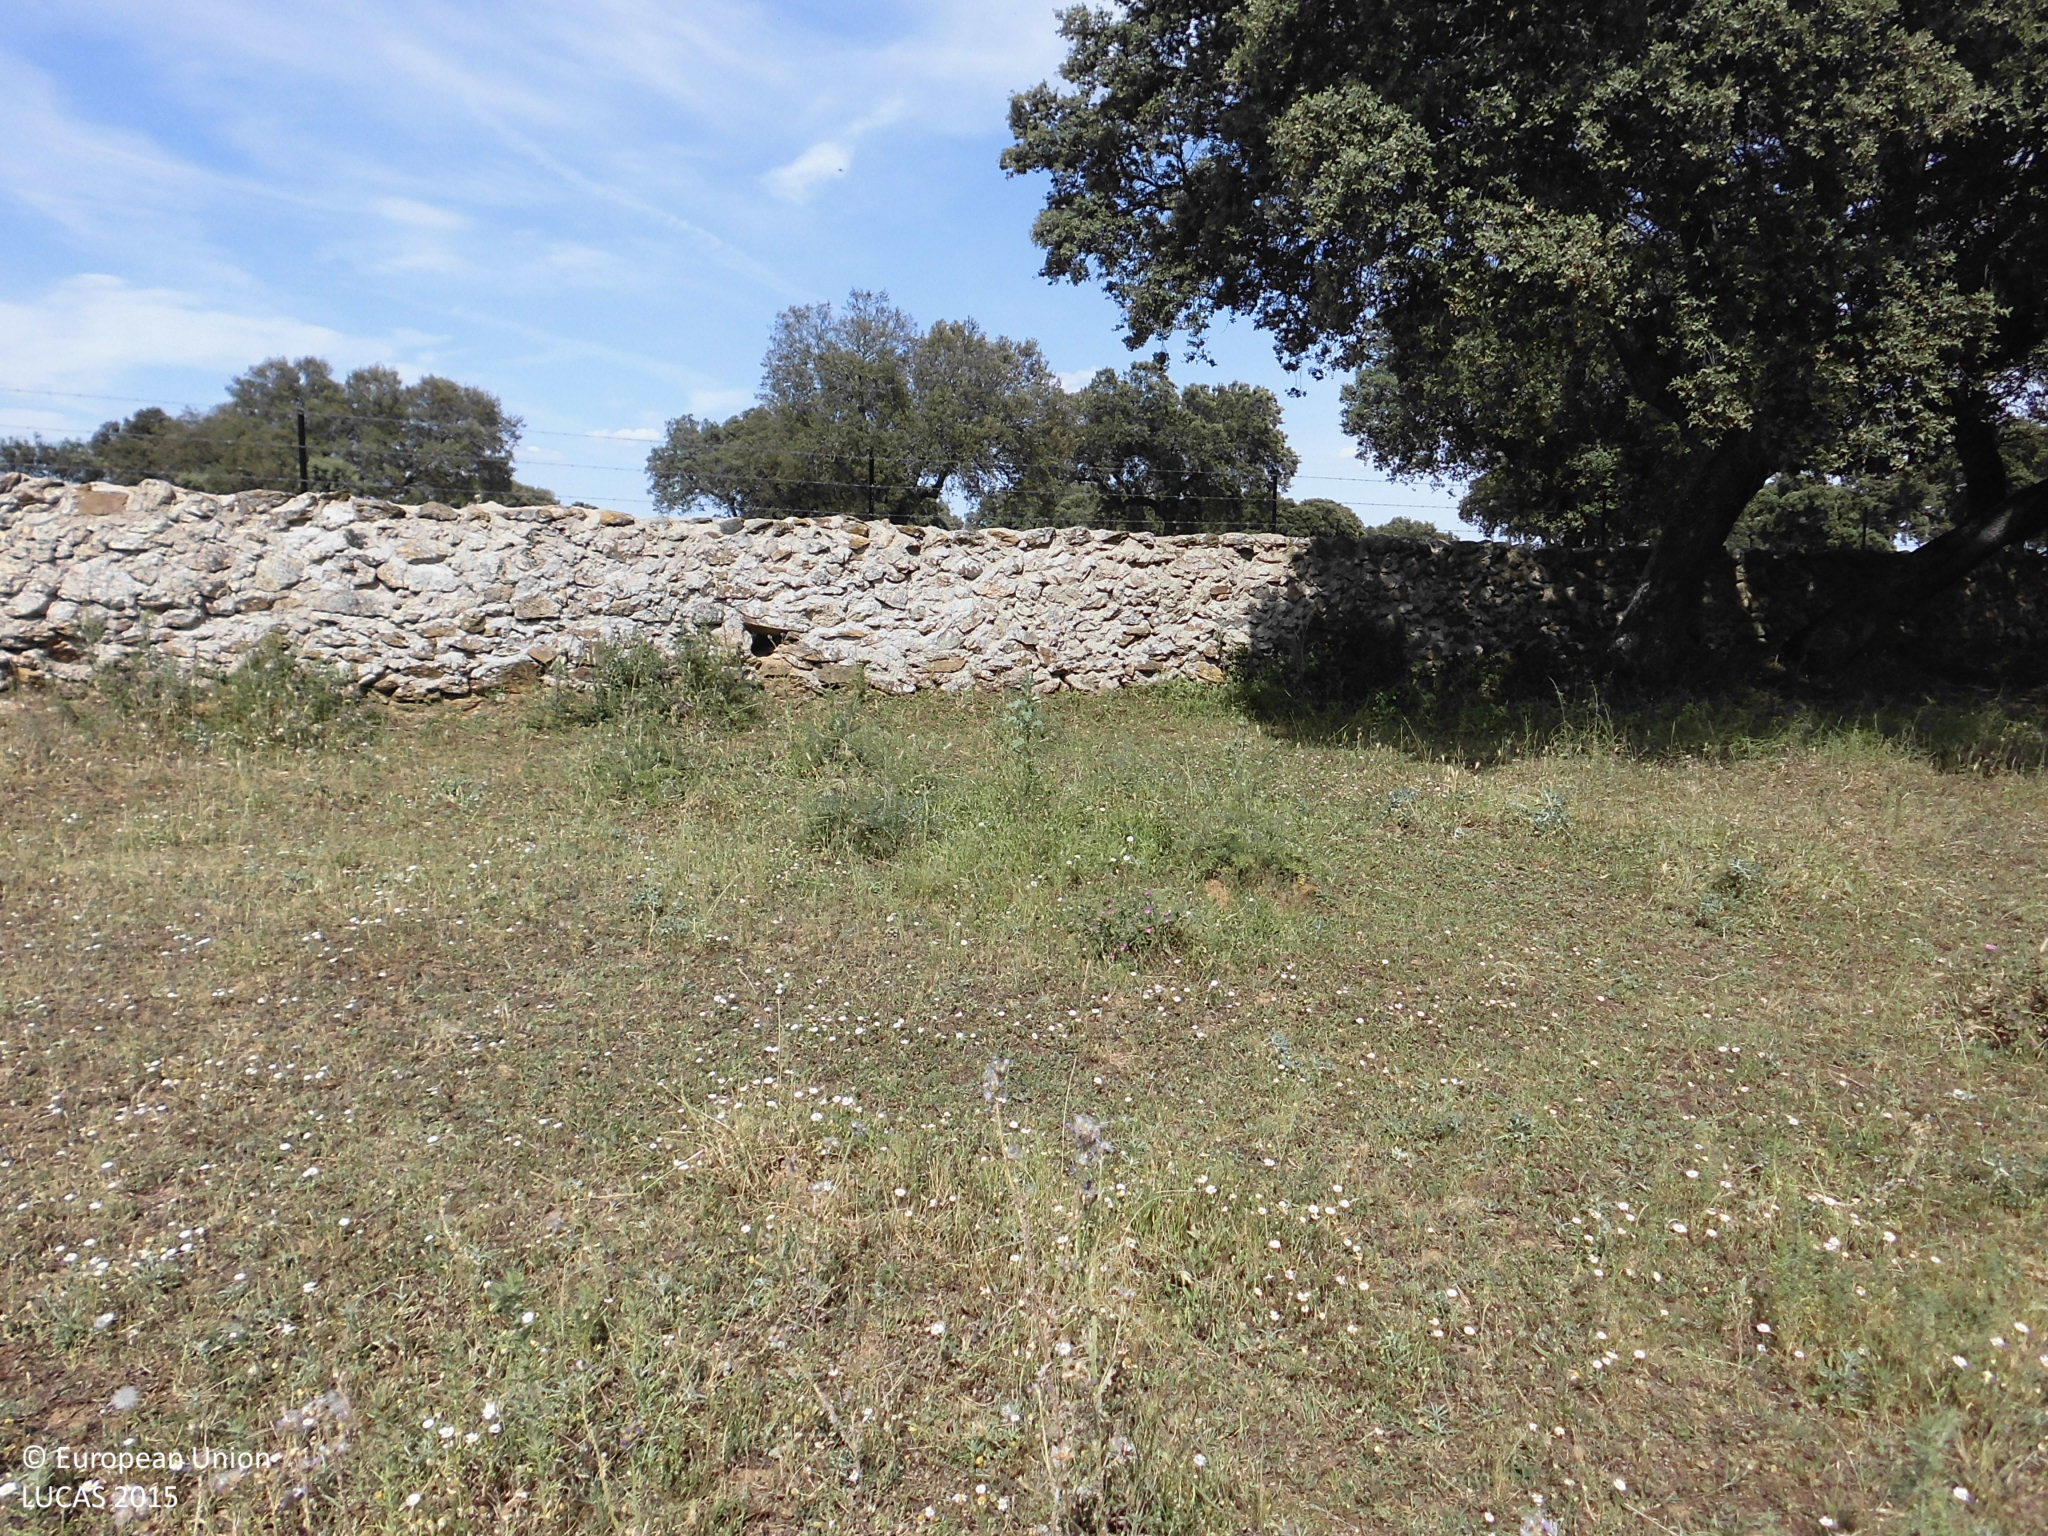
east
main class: Woodland
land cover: Broadleaved woodland
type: broadleaved evergreen forest
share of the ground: 10 - 25 %
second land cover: Grassland without tree/shrub cover
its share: > 75 %
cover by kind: herbaceous plants 75 %, broadleaved forest trees 25 %
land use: Forestry
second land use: Agriculture (excluding fallow land and kitchen gardens)
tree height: > 5 m
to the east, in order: Broadleaved woodland; Grassland without tree/shrub cover; Broadleaved woodland; Dry stone walls; Grassland without tree/shrub cover; Tracks; Broadleaved woodland
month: May
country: ES
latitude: 39.6131
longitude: -6.7224
